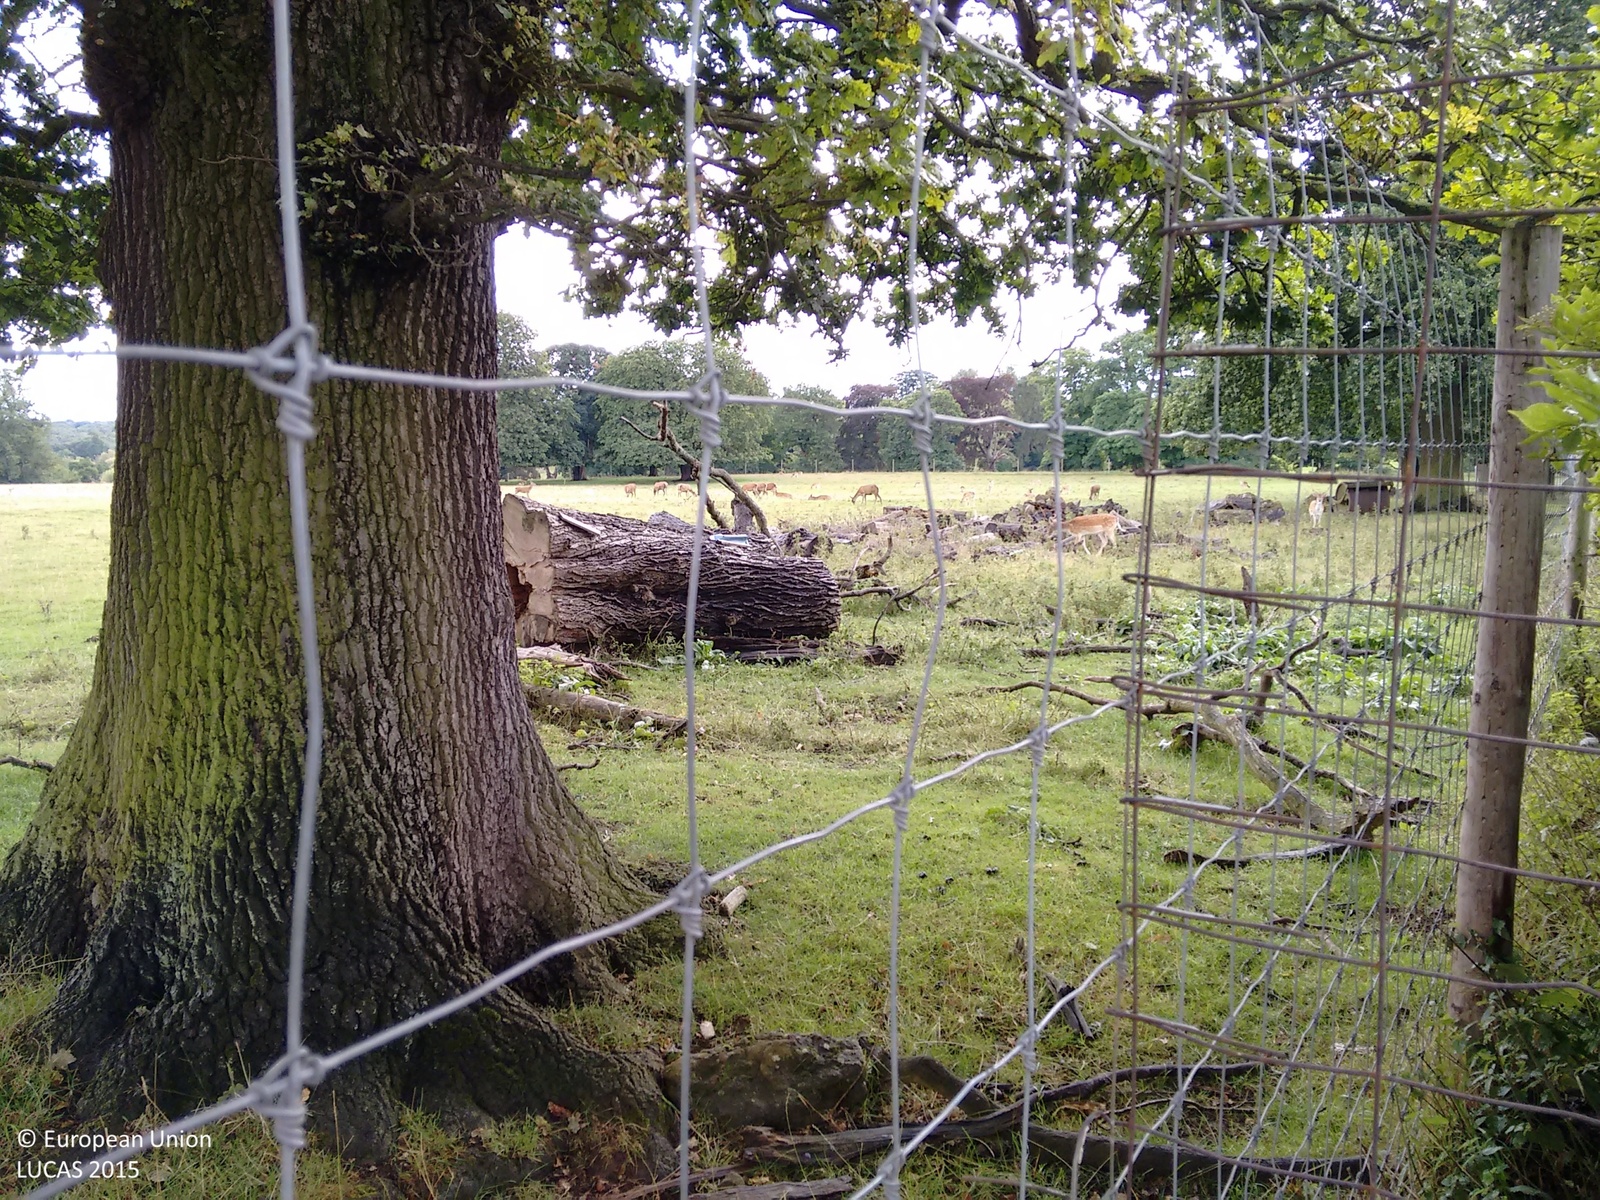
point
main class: Grassland
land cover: Grassland without tree/shrub cover
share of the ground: > 75 %
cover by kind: herbaceous plants 100 %
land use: Agriculture (excluding fallow land and kitchen gardens)
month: September
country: GB
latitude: 52.8017
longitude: -1.4564
